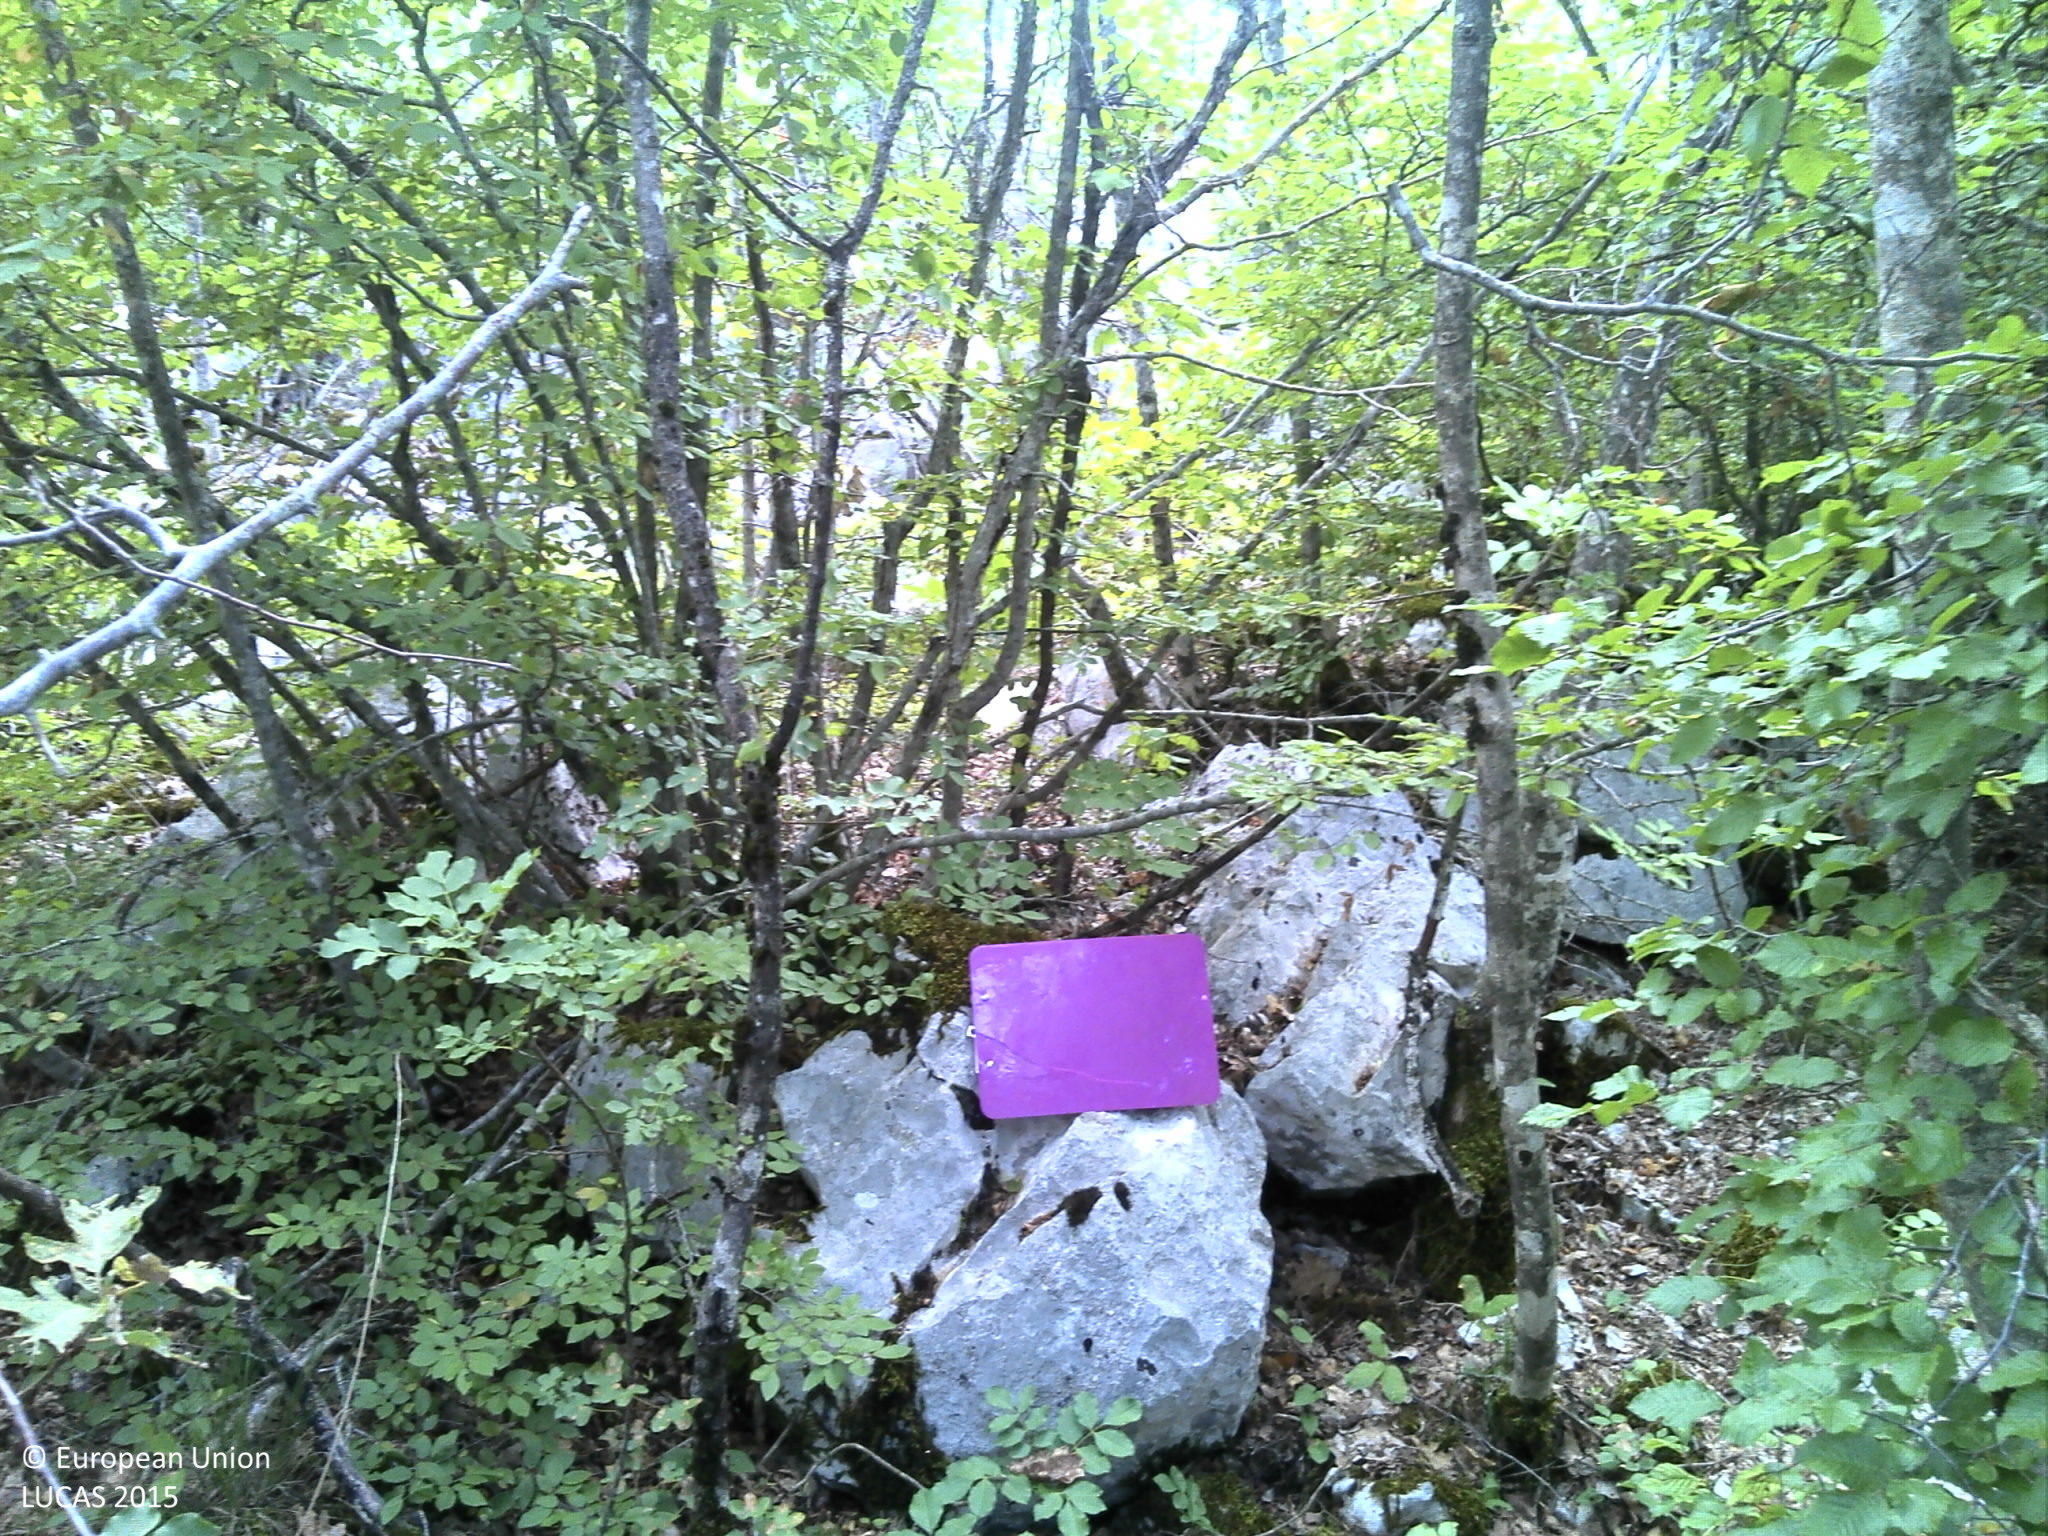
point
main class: Woodland
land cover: Broadleaved woodland
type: thermophilous deciduous forest
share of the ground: > 75 %
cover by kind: broadleaved forest trees 45 %, shrubs 30 %, herbaceous plants 10 %, consolidated bare surface 10 %, unconsolidated bare surface 5 %
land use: Semi-natural and natural areas not in use
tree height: > 5 m
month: August
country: HR
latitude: 43.3178
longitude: 17.2541
